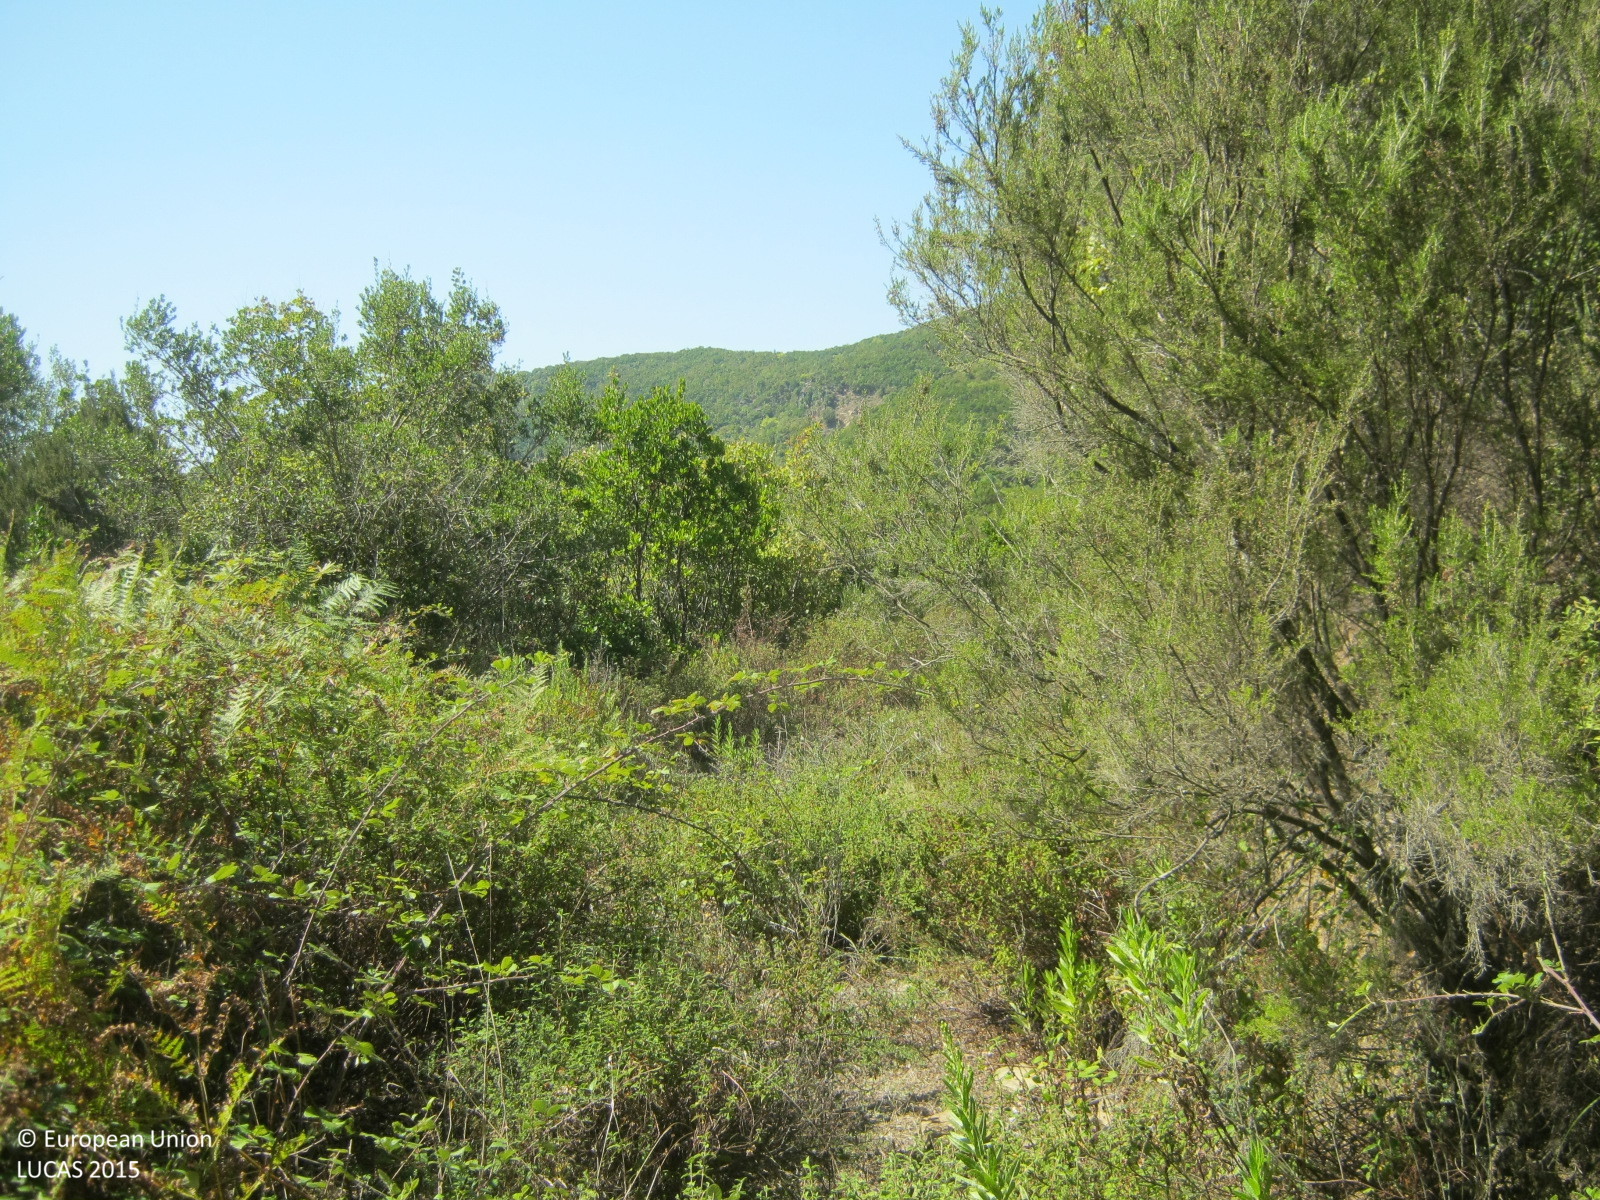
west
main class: Woodland
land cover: Broadleaved woodland
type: broadleaved evergreen forest
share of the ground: > 75 %
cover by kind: broadleaved forest trees 100 %
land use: Semi-natural and natural areas not in use
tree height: > 5 m
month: September
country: GR
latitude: 39.3251
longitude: 21.1006
